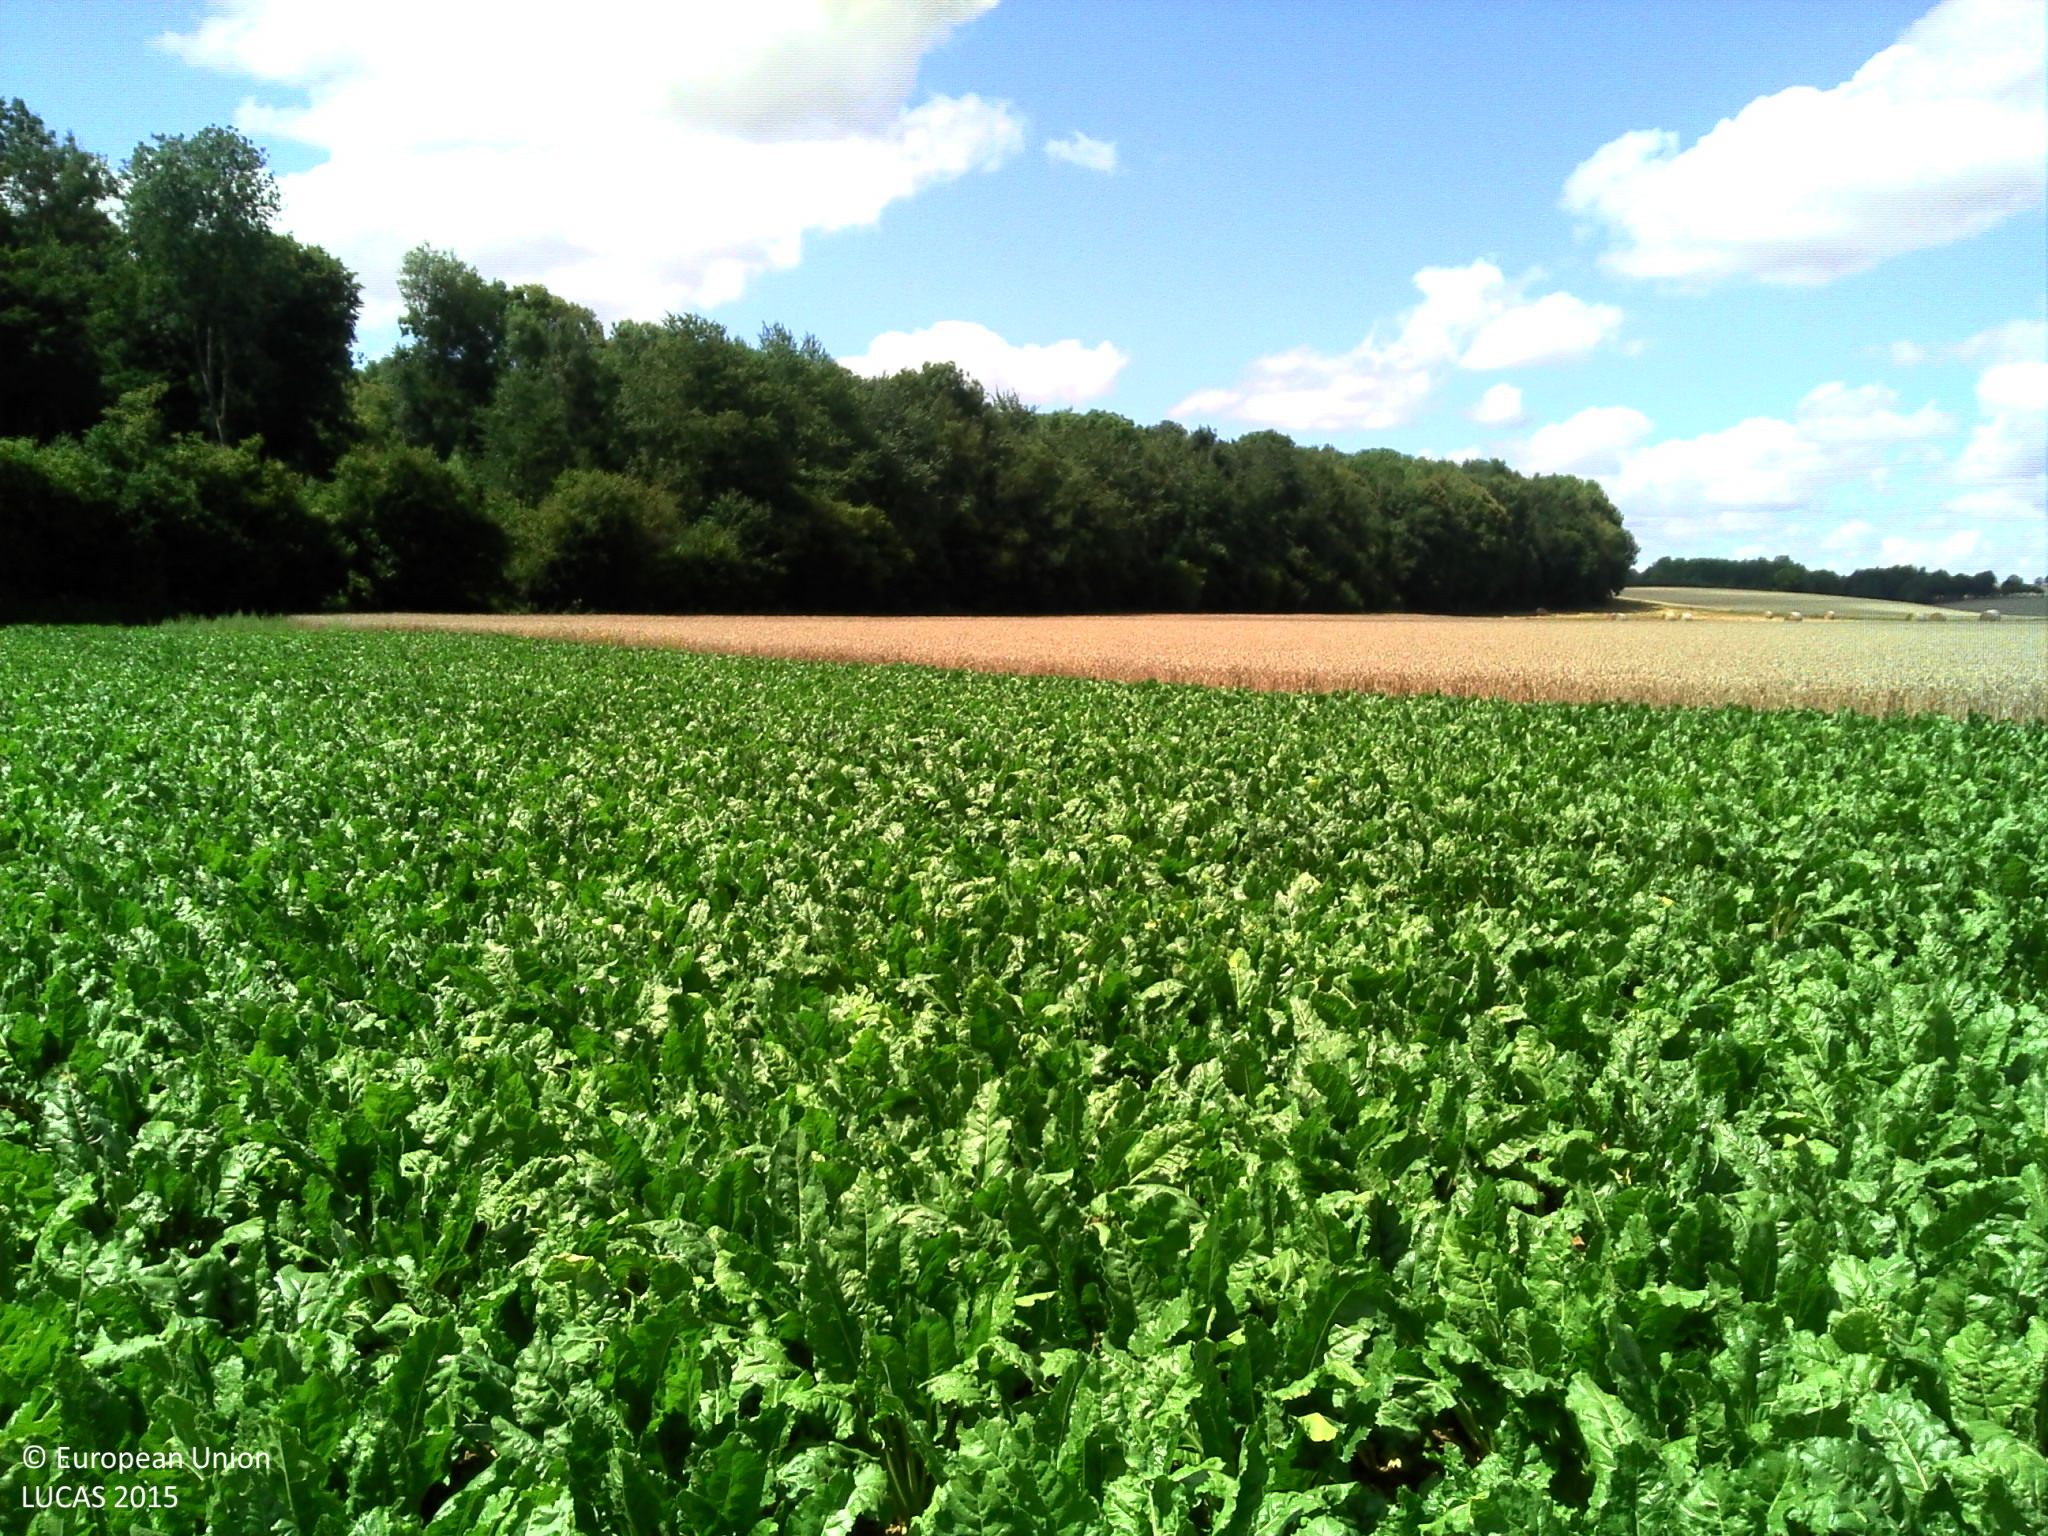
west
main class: Cropland
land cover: Sugar beet
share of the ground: > 75 %
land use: Agriculture (excluding fallow land and kitchen gardens)
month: July
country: FR
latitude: 50.0052
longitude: 2.4389
